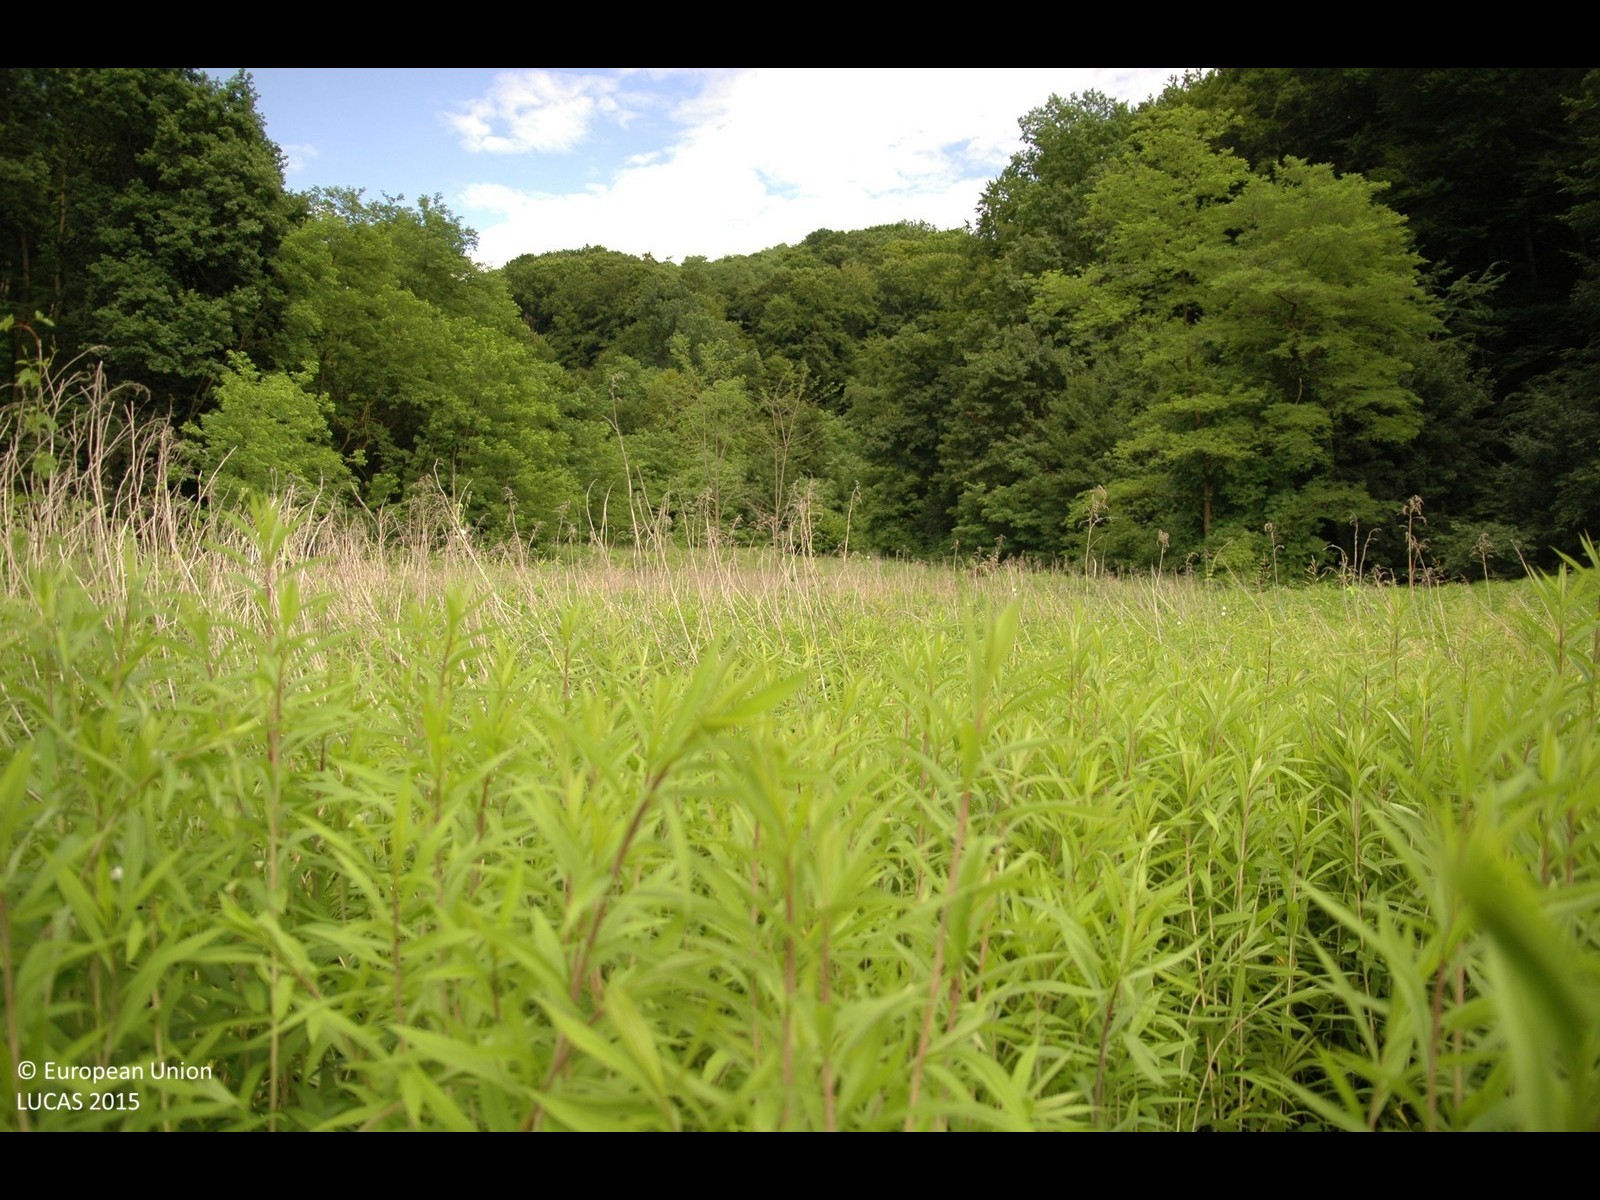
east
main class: Shrubland
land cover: Shrubland without tree cover
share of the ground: > 75 %
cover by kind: shrubs 90 %, herbaceous plants 10 %
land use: Fallow land
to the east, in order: Shrubland without tree cover; Tracks; Broadleaved woodland; Tracks; Broadleaved woodland
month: June
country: HR
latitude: 46.0630
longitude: 15.8802
